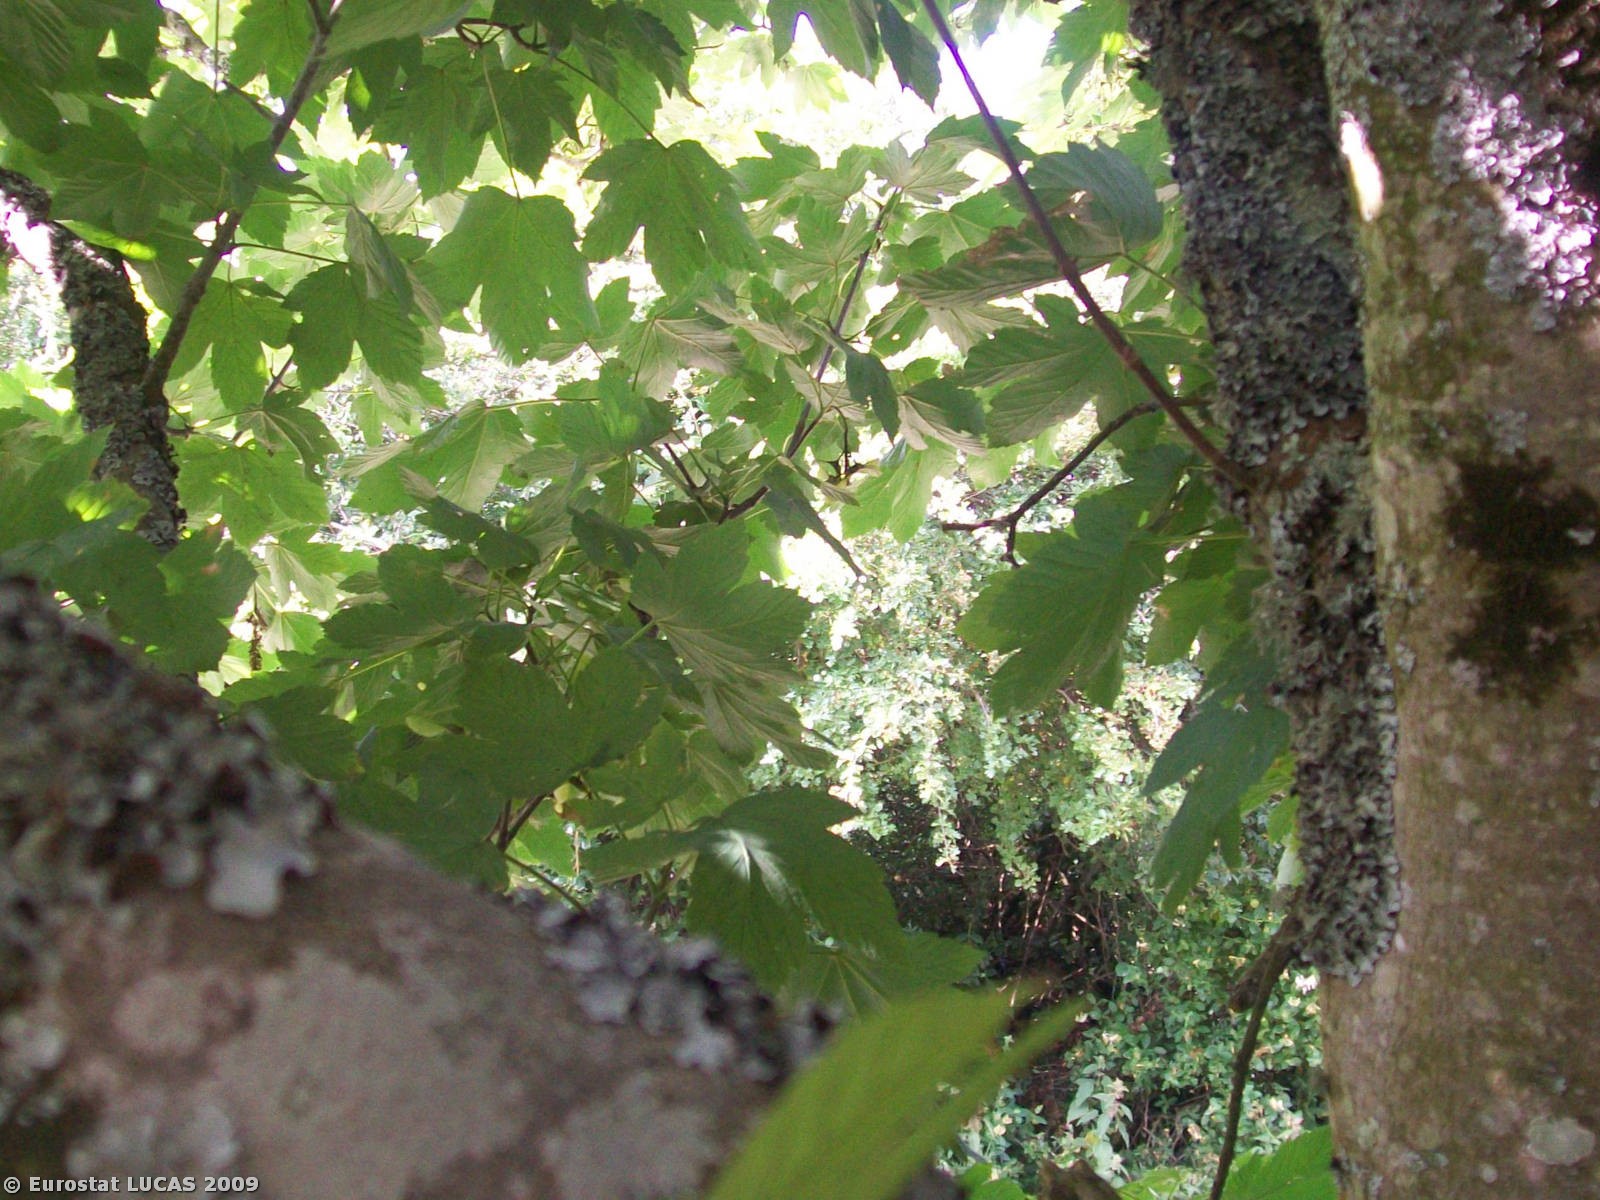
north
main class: Grassland
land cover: Grassland without tree/shrub cover
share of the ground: > 75 %
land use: Agriculture (excluding fallow land and kitchen gardens)
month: July
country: GB
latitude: 50.3157
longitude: -5.1601
